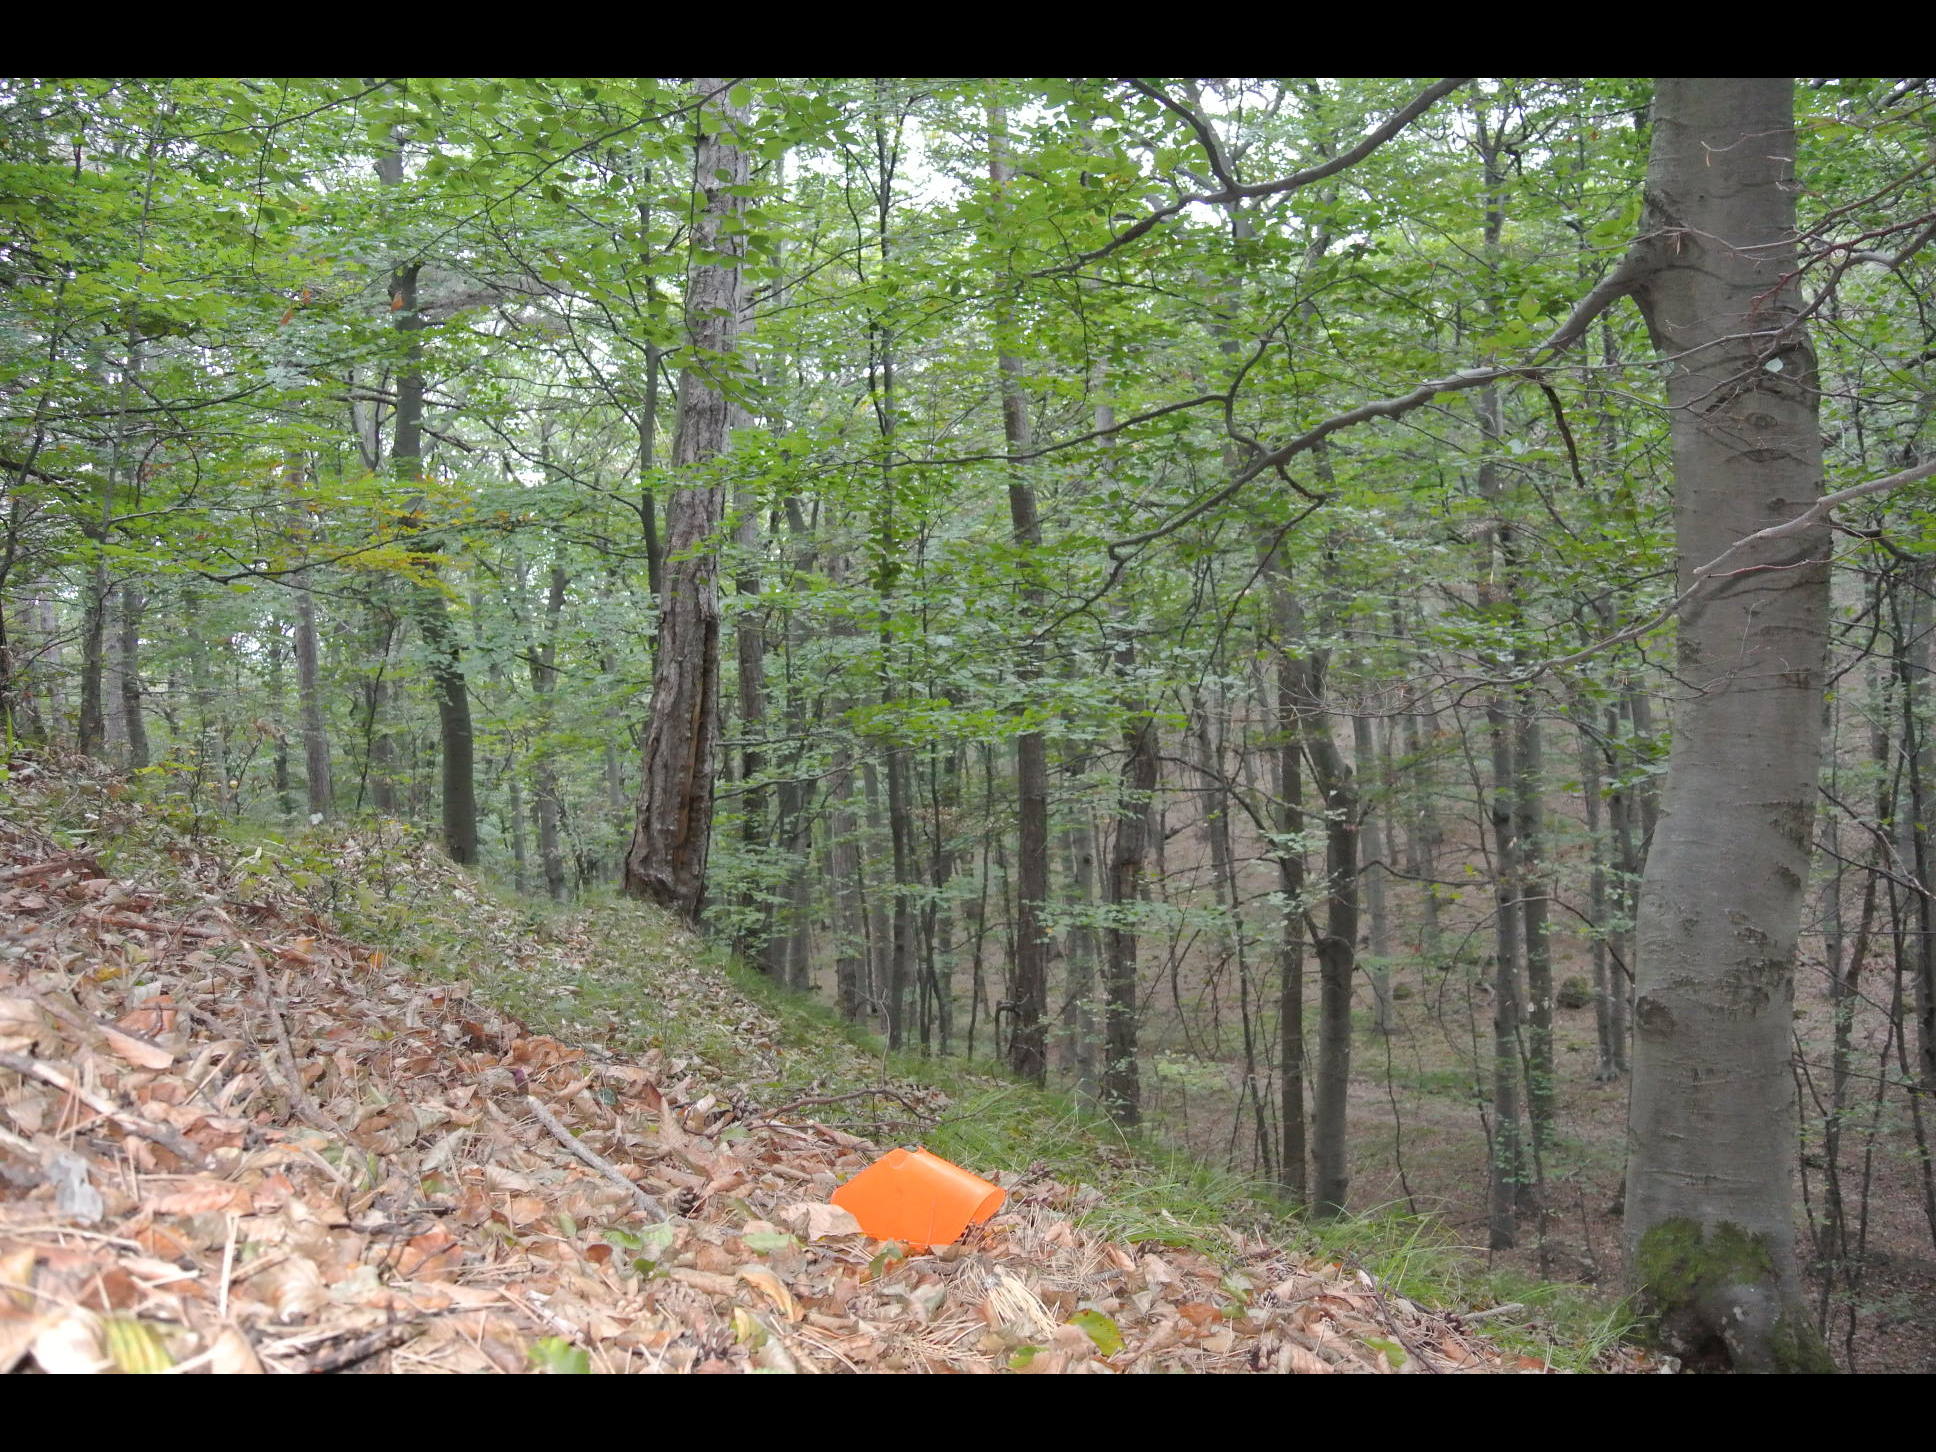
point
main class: Woodland
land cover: Pine dominated mixed woodland
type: beech forest
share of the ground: > 75 %
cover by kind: broadleaved forest trees 75 %, coniferous forest trees 25 %
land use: Forestry
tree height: > 5 m
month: July
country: AT
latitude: 47.9959
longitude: 16.1820
